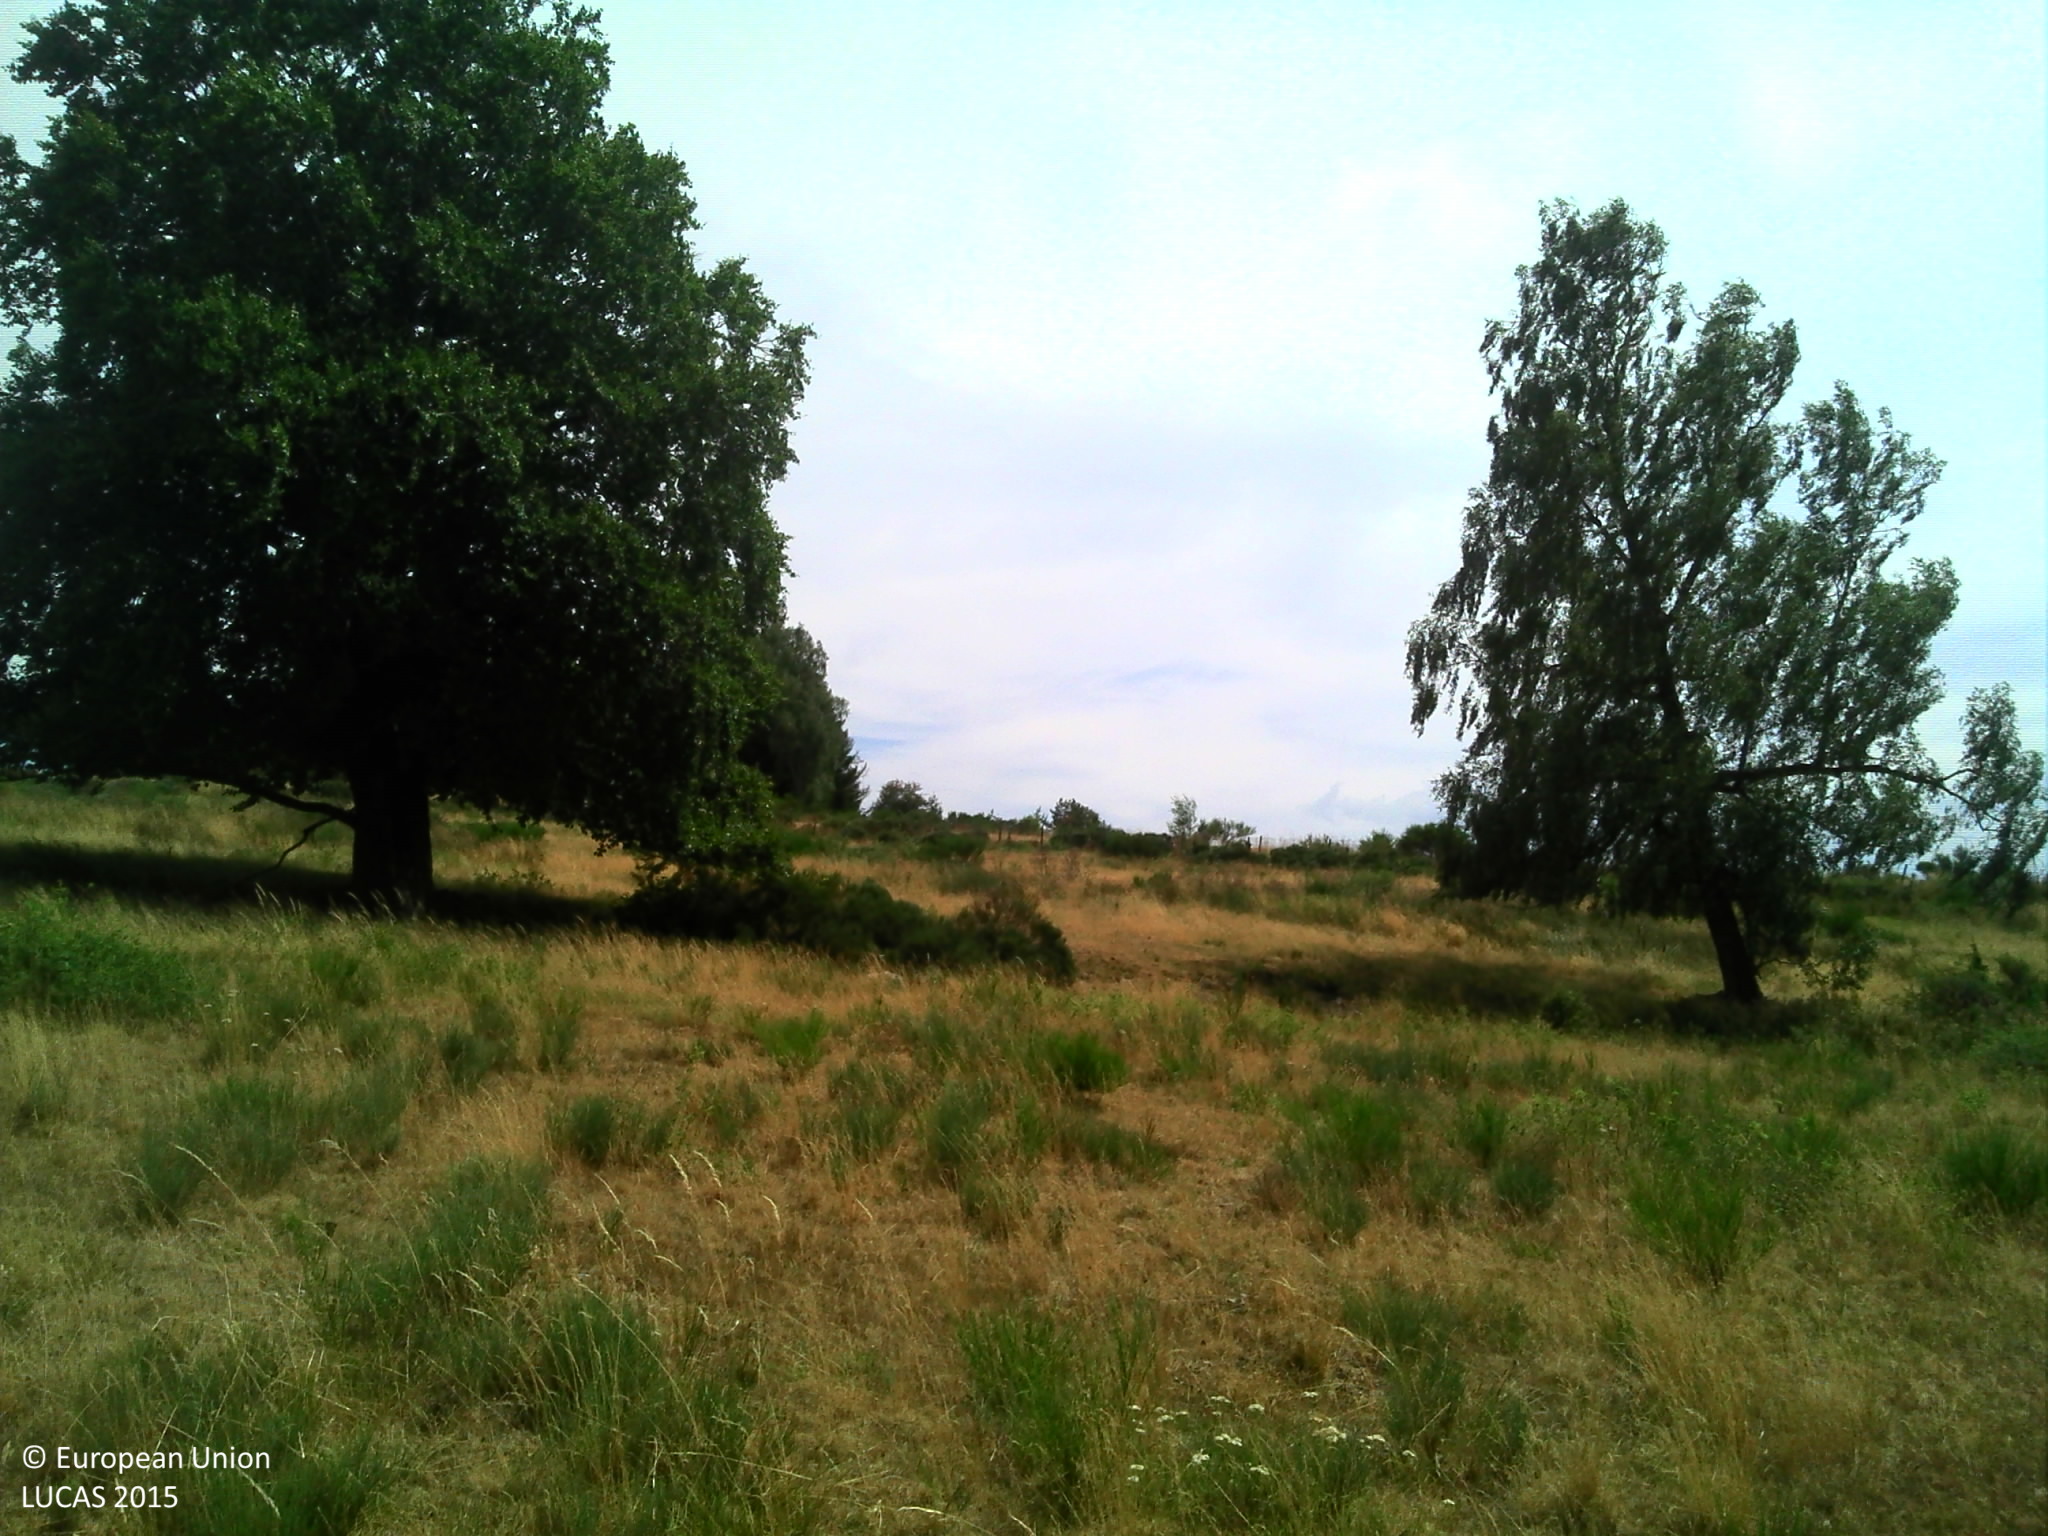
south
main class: Grassland
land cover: Grassland with sparse tree/shrub cover
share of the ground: > 75 %
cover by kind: herbaceous plants 85 %, shrubs 10 %, coniferous forest trees 5 %
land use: Agriculture (excluding fallow land and kitchen gardens)
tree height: < 5 m
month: July
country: FR
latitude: 44.6901
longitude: 3.2280
